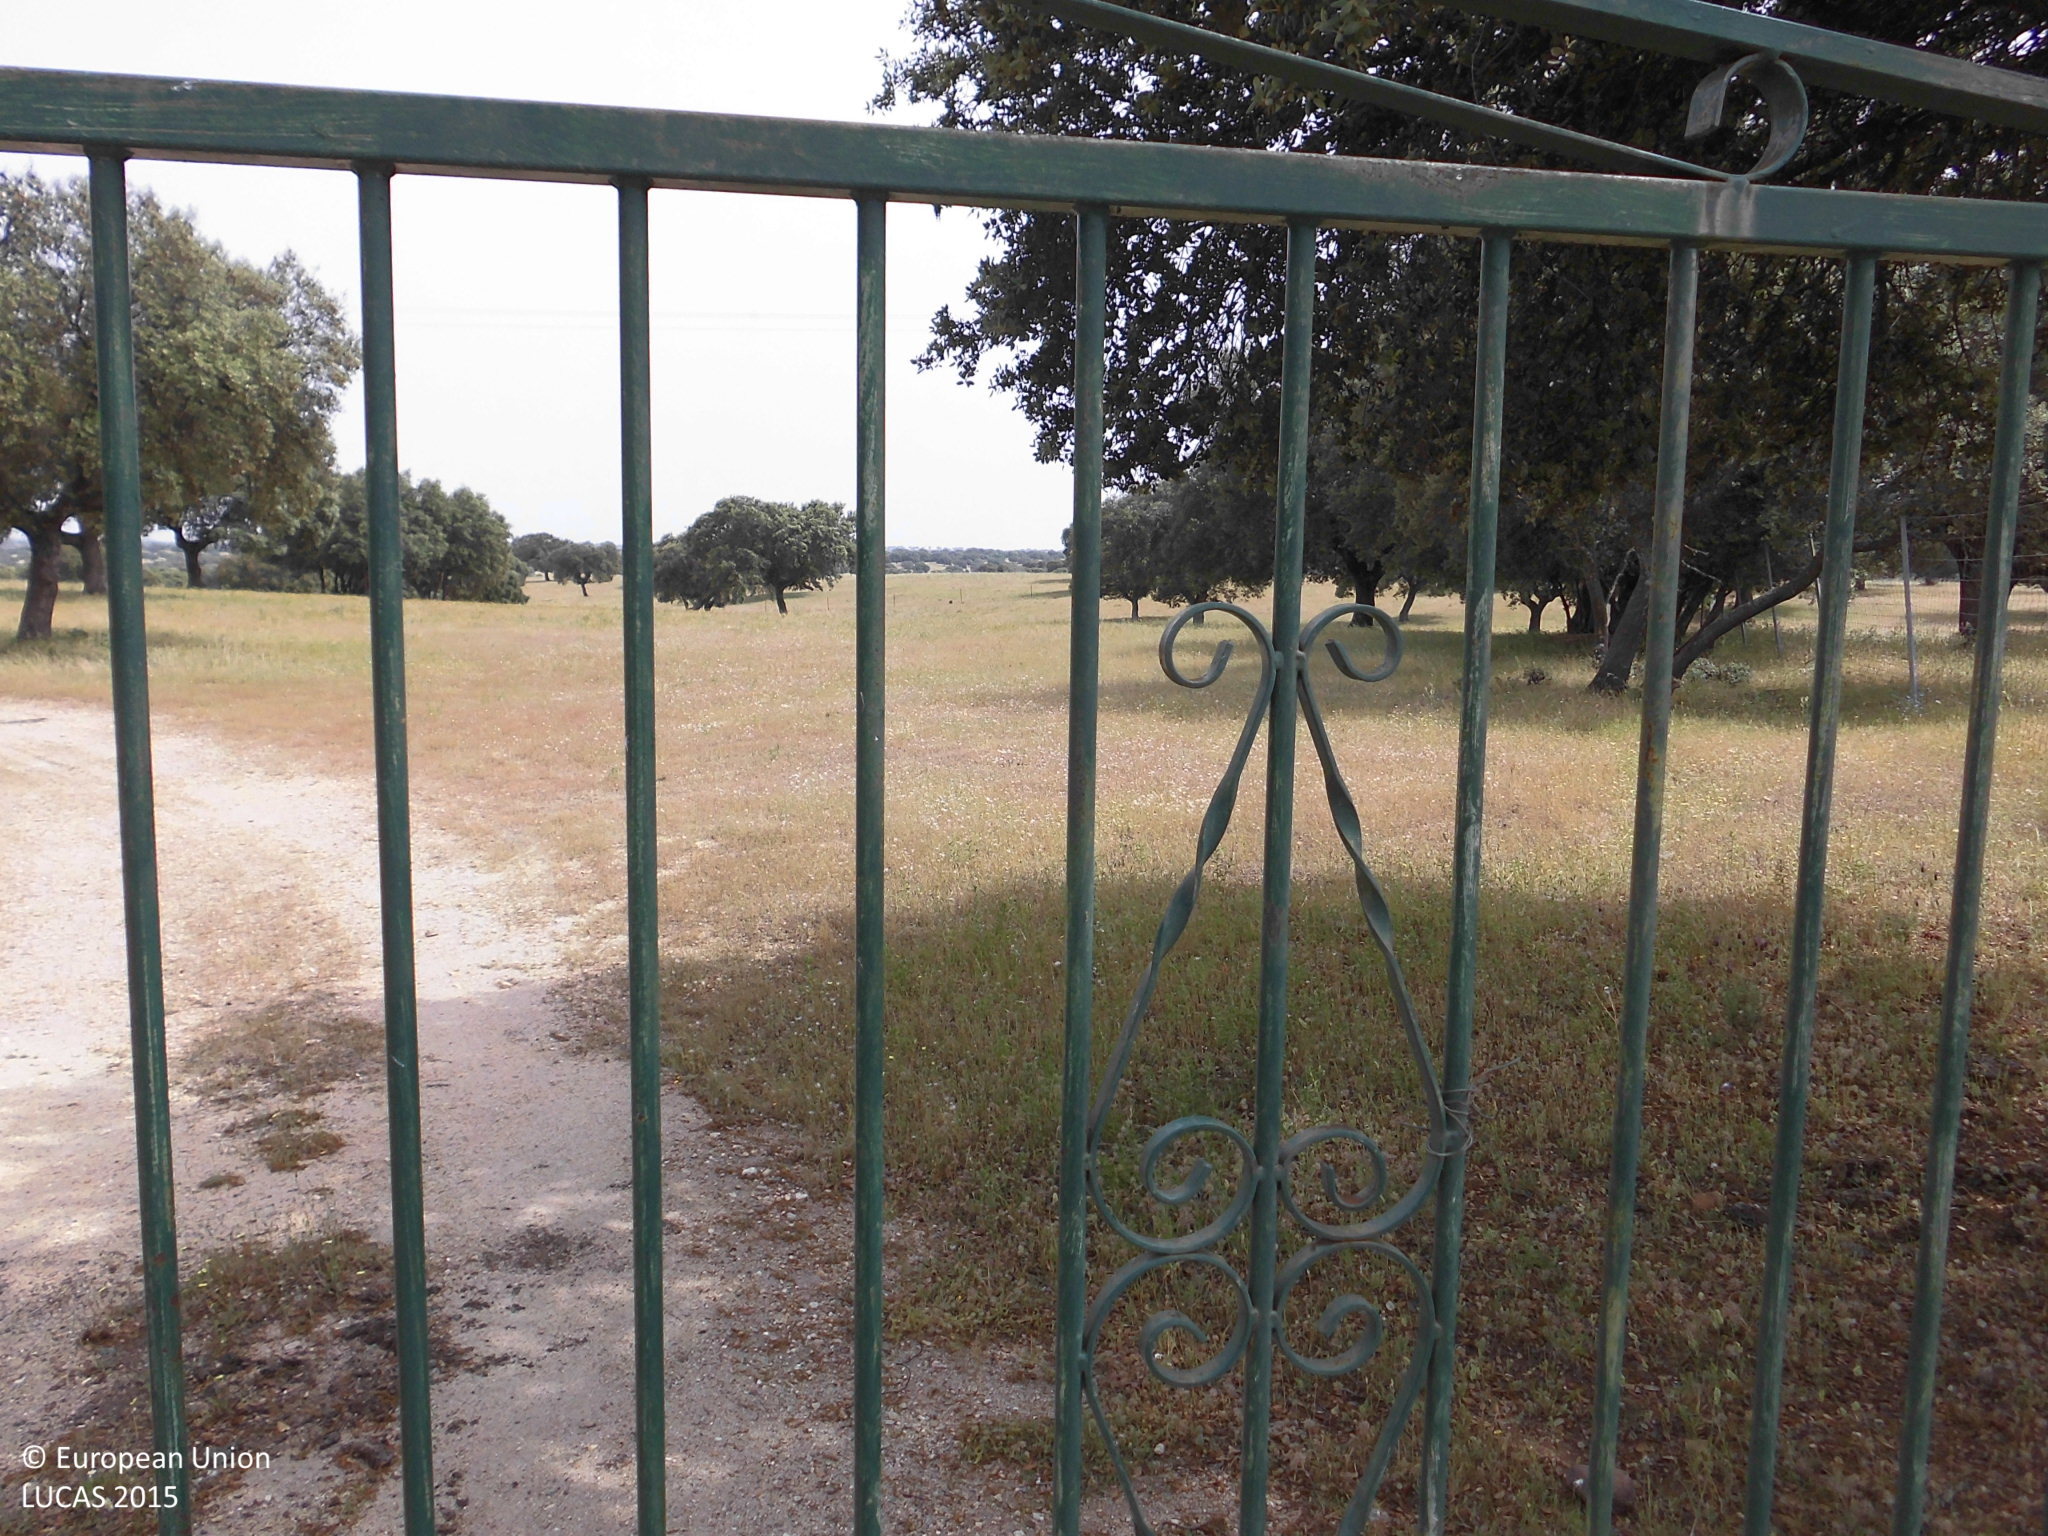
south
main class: Woodland
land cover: Broadleaved woodland
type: broadleaved evergreen forest
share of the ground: 10 - 25 %
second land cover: Grassland without tree/shrub cover
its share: > 75 %
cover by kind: herbaceous plants 90 %, broadleaved forest trees 10 %
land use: Forestry
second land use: Agriculture (excluding fallow land and kitchen gardens)
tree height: > 5 m
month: May
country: ES
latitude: 39.7182
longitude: -6.1068
